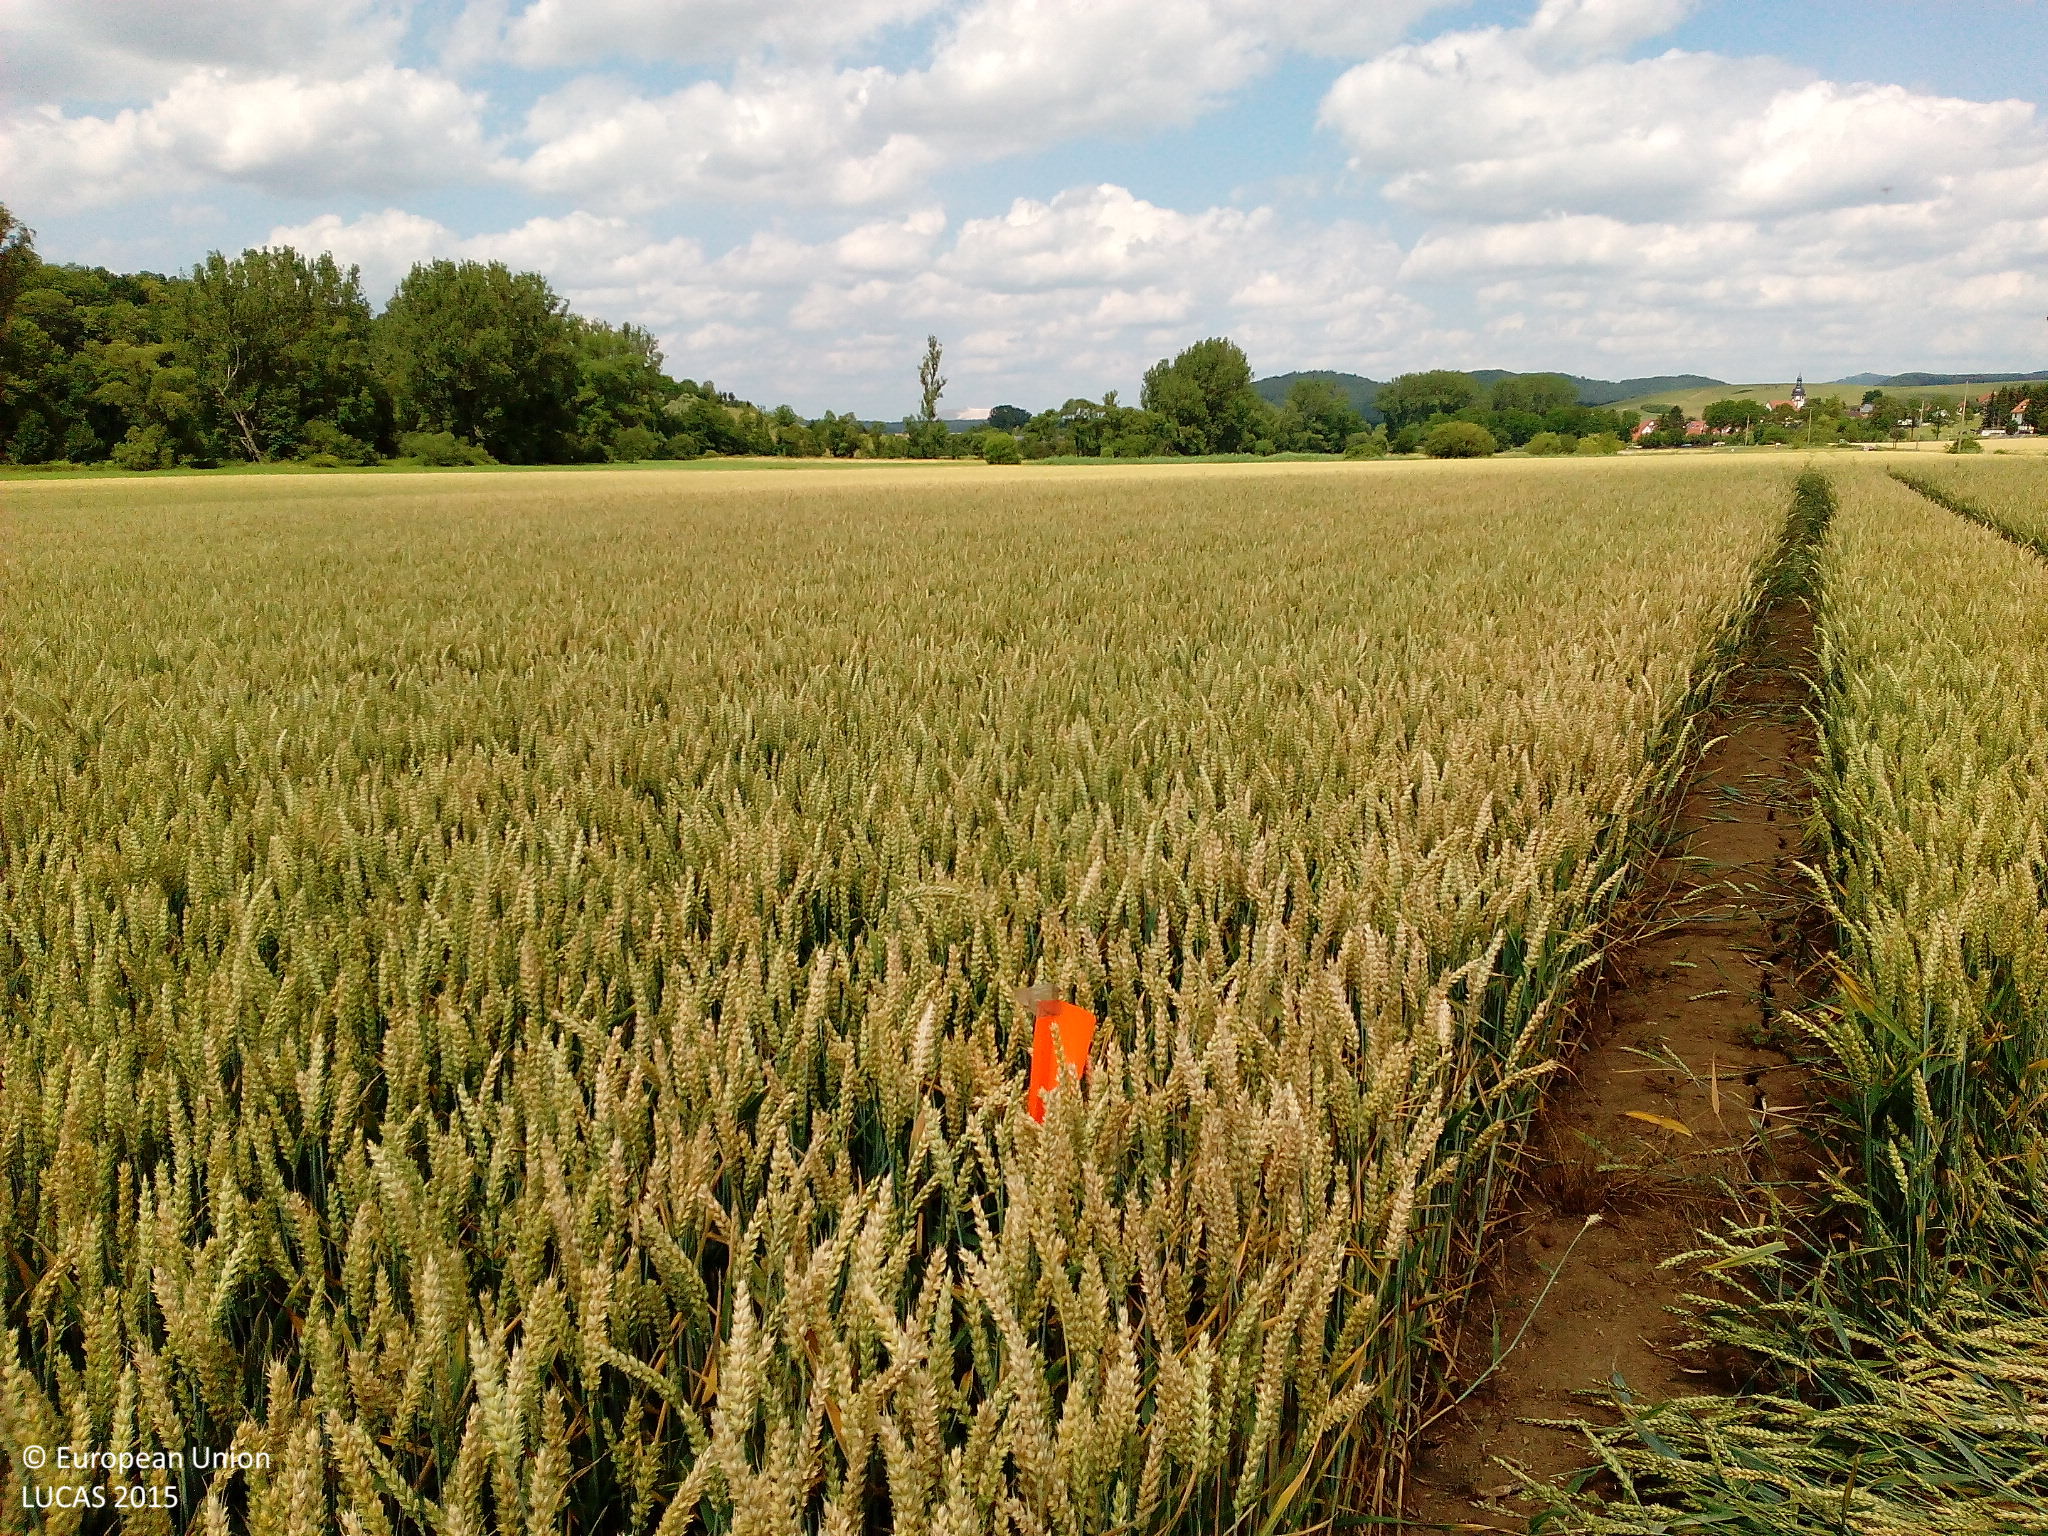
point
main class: Cropland
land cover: Common wheat
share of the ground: > 75 %
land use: Agriculture (excluding fallow land and kitchen gardens)
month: July
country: DE
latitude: 50.7236
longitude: 9.9575
